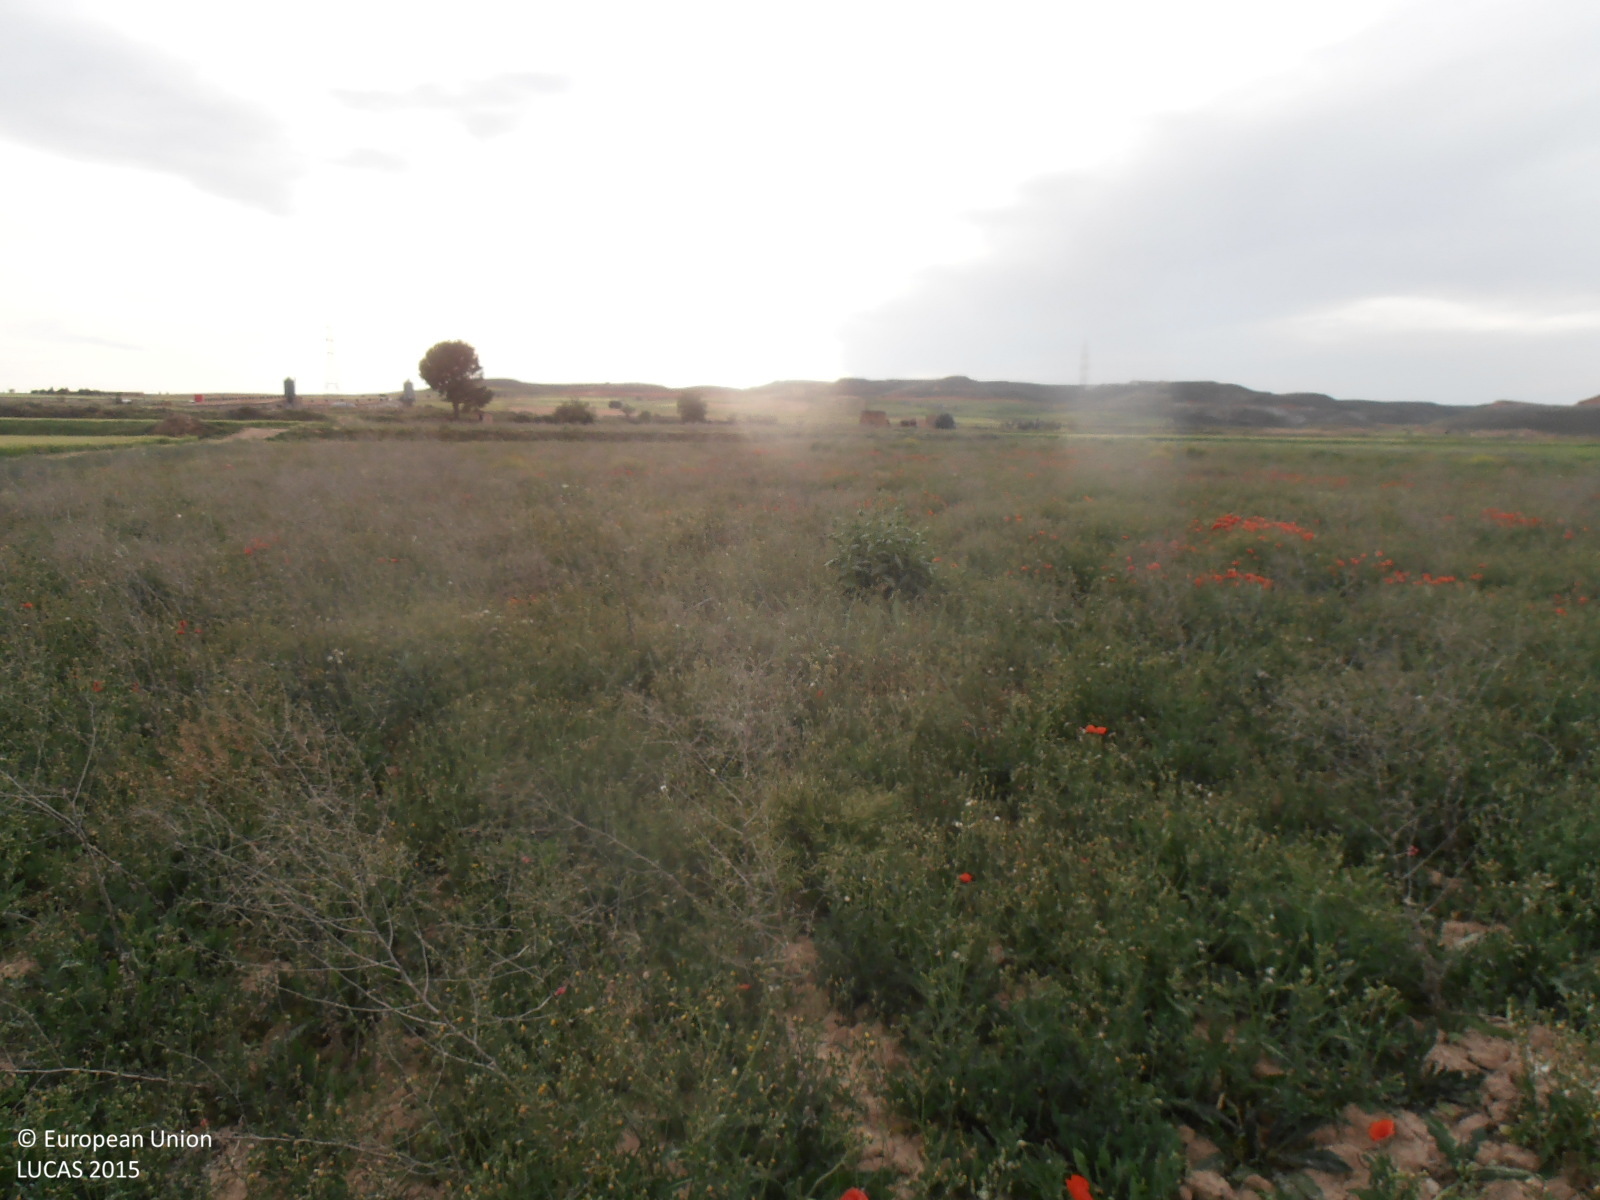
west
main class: Grassland
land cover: Spontaneously vegetated surfaces
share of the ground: > 75 %
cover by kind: herbaceous plants 100 %
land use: Fallow land
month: April
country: ES
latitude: 41.3371
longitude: -0.3757
